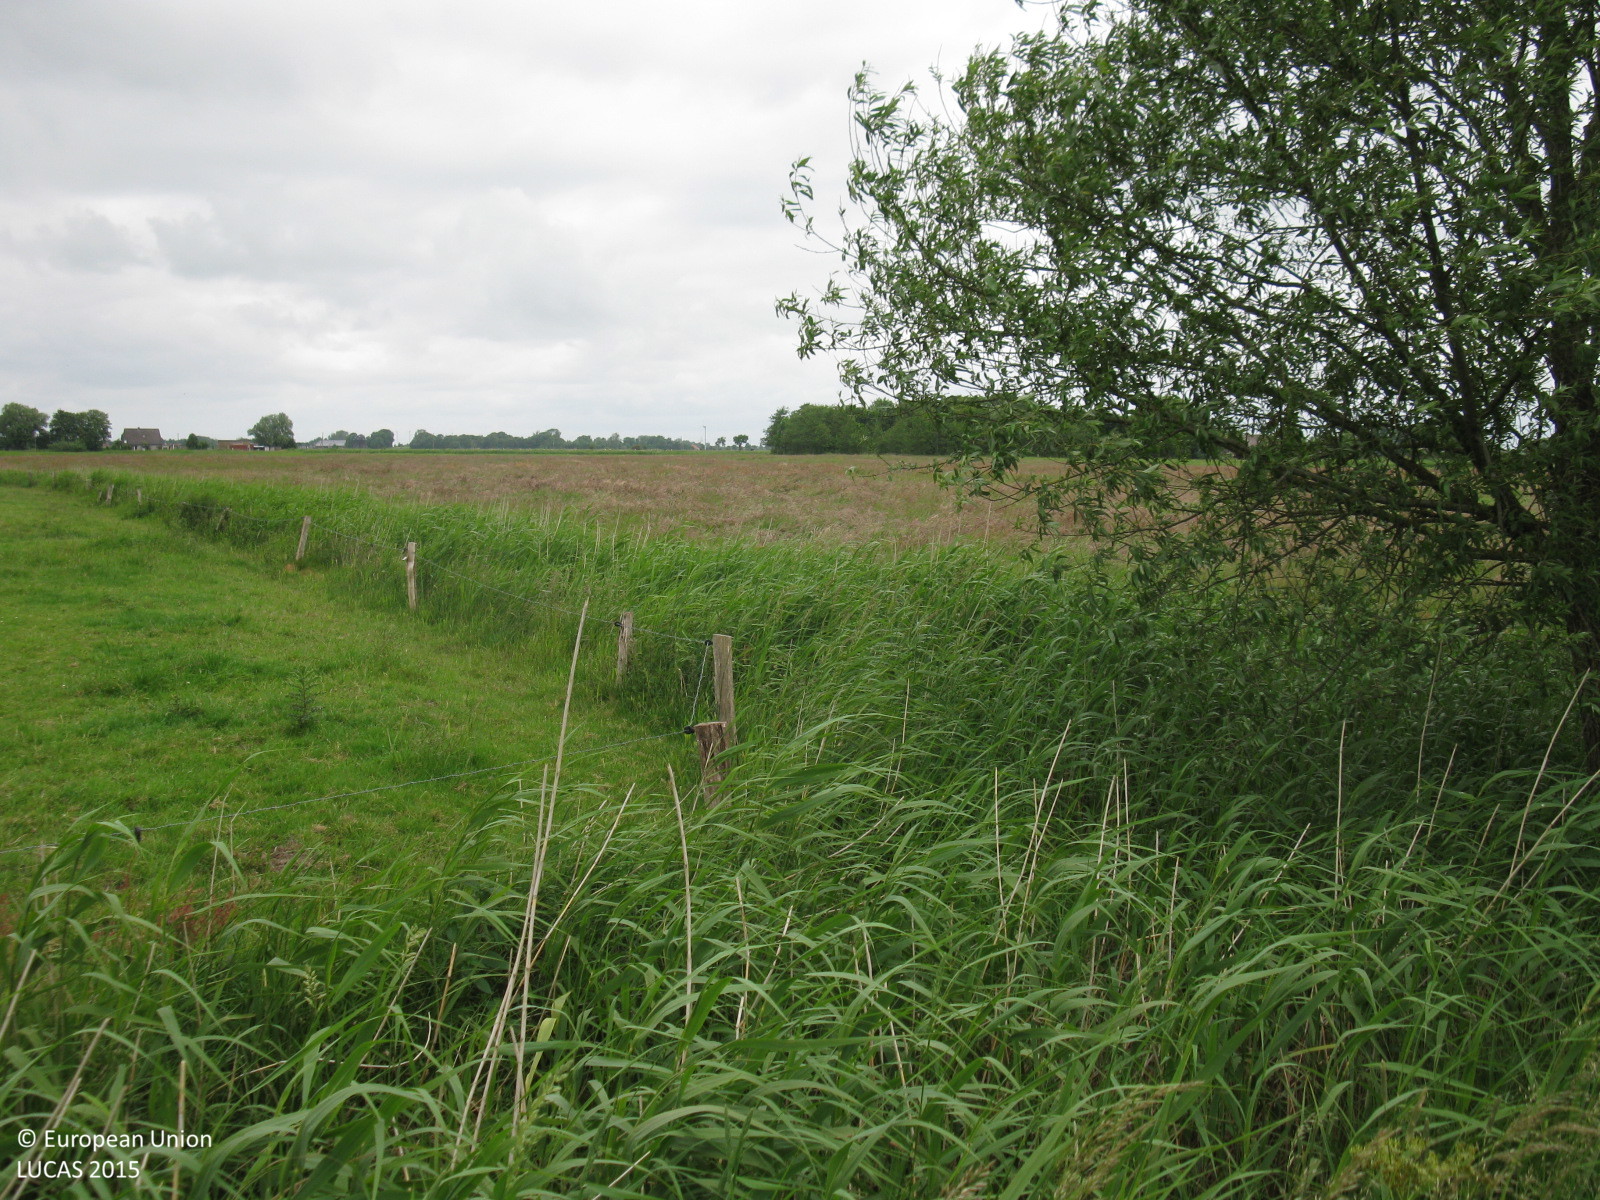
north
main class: Grassland
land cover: Grassland without tree/shrub cover
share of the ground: > 75 %
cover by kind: herbaceous plants 100 %
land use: Agriculture (excluding fallow land and kitchen gardens)
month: June
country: DE
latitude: 53.6175
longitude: 7.8995
